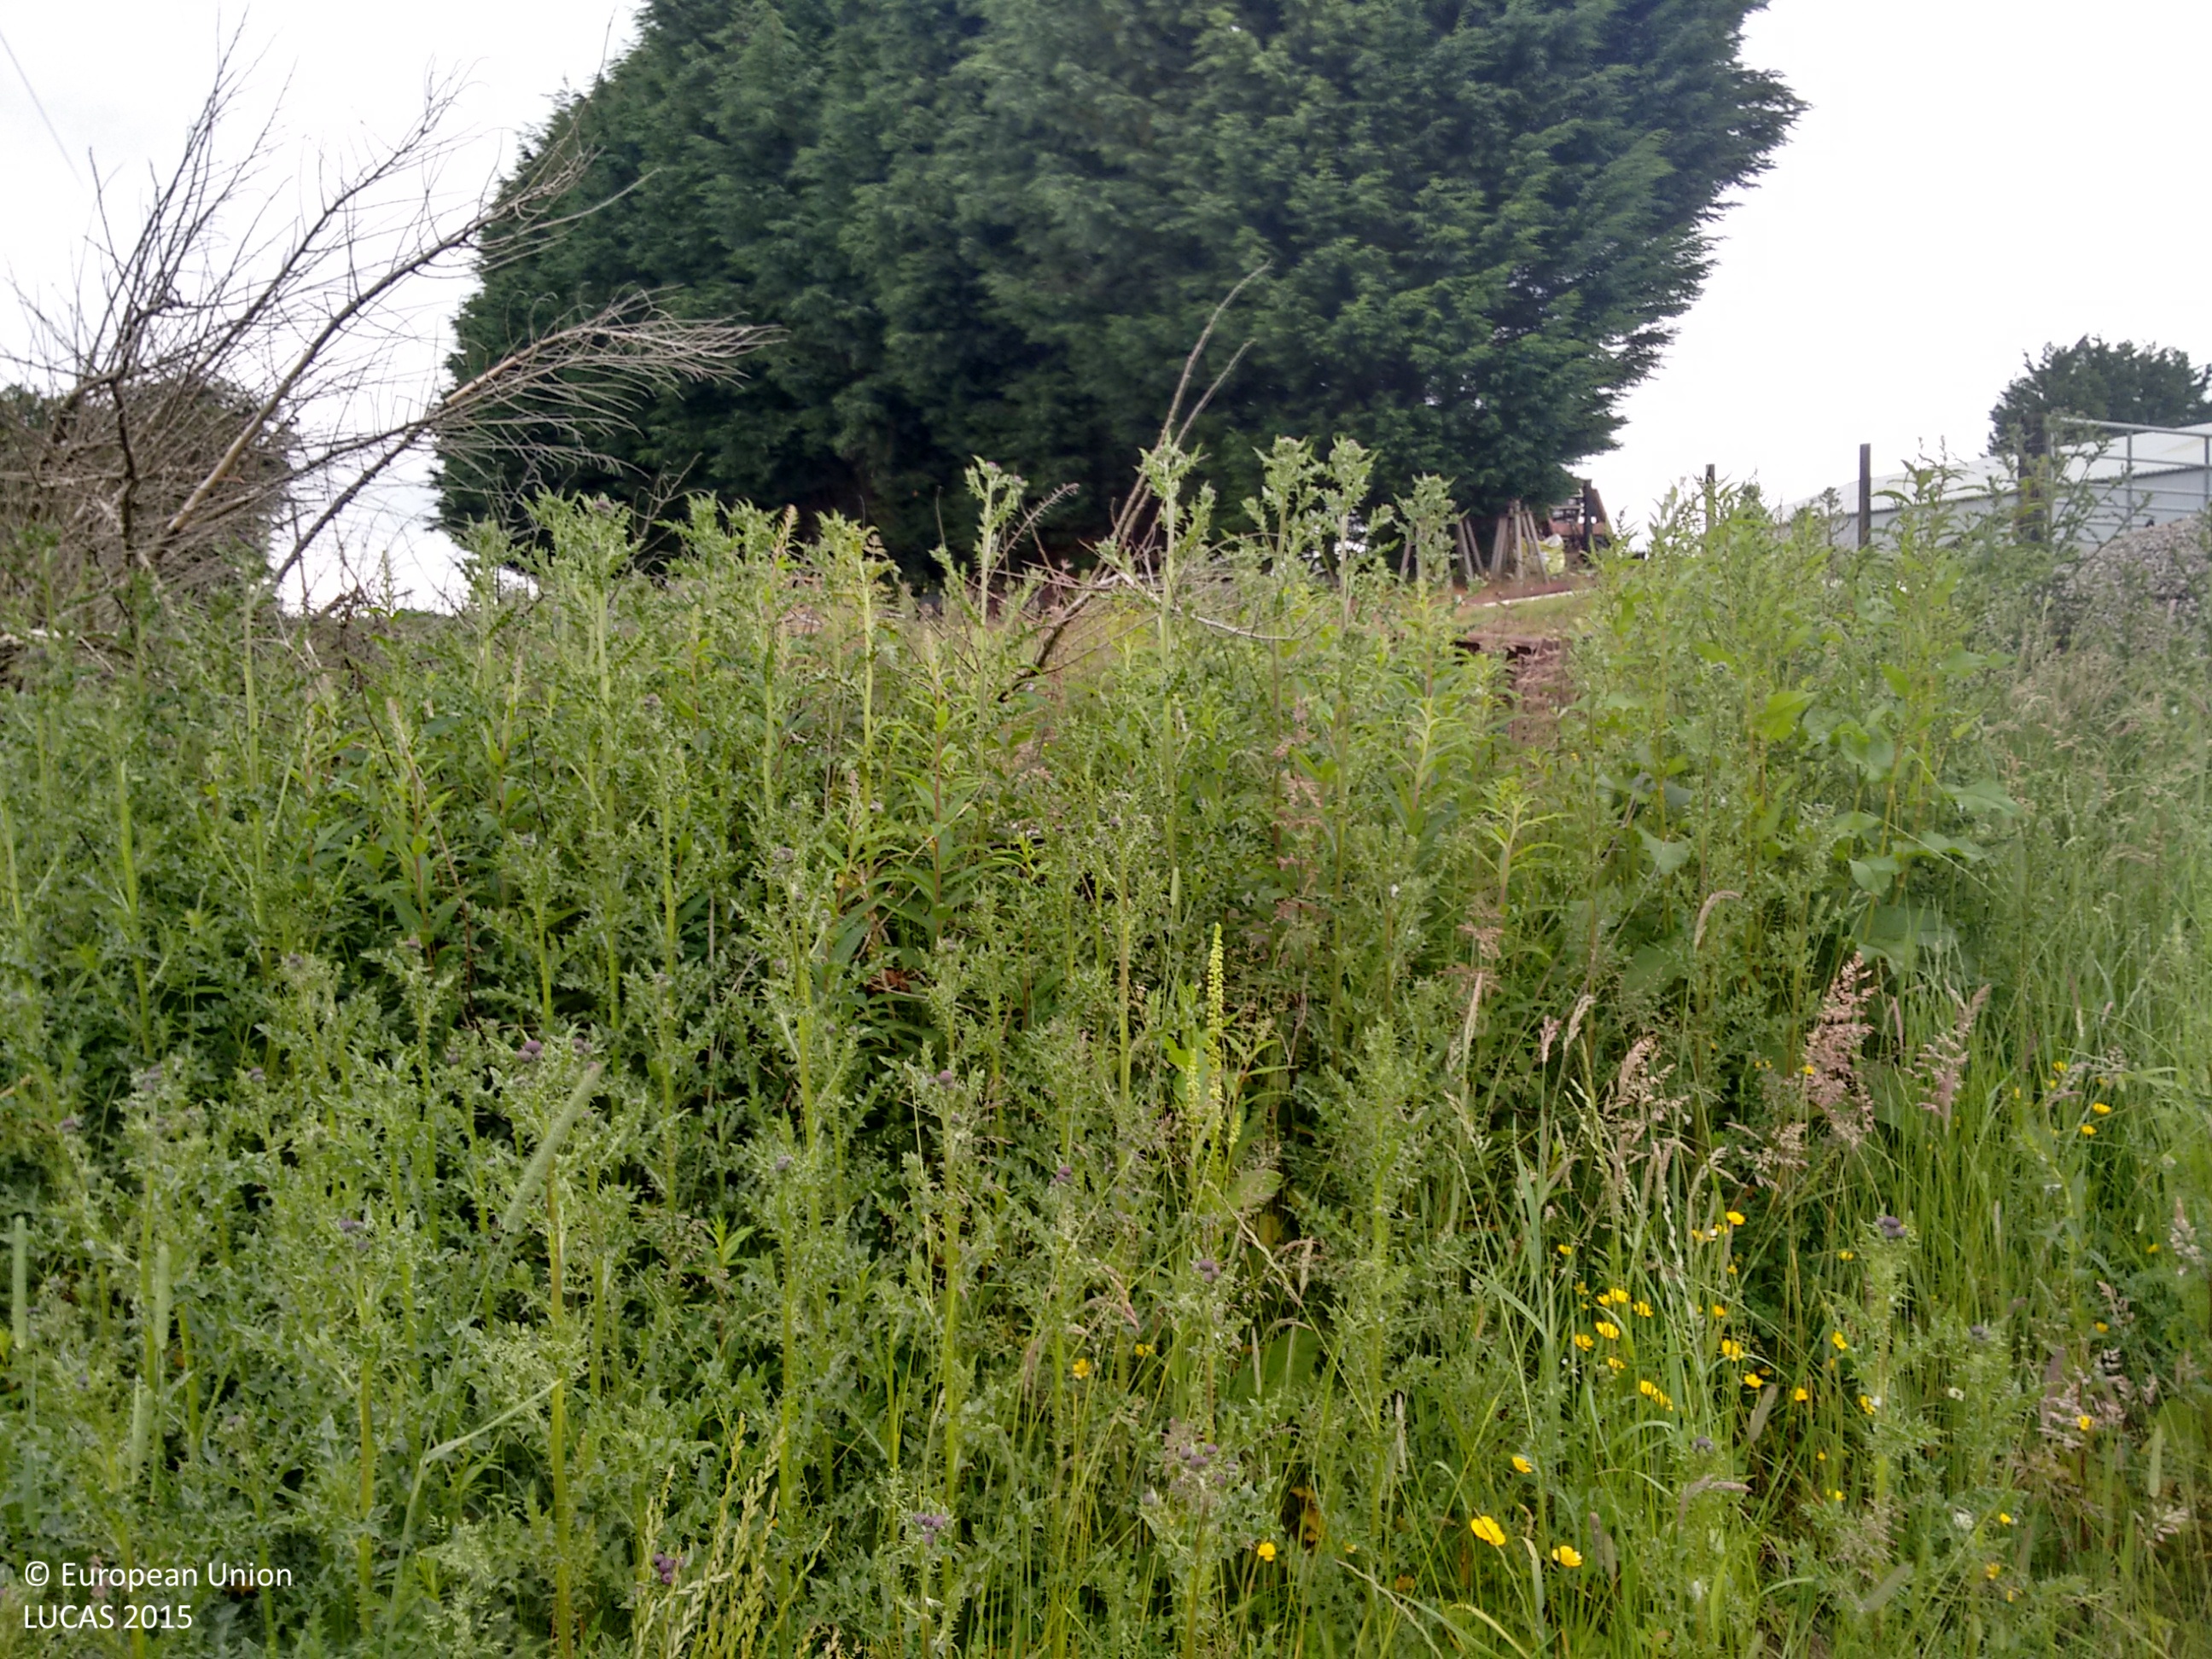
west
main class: Grassland
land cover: Spontaneously vegetated surfaces
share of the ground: 50 - 75 %
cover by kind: herbaceous plants 100 %
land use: Agriculture (excluding fallow land and kitchen gardens)
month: June
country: GB
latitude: 55.7340
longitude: -3.9259
